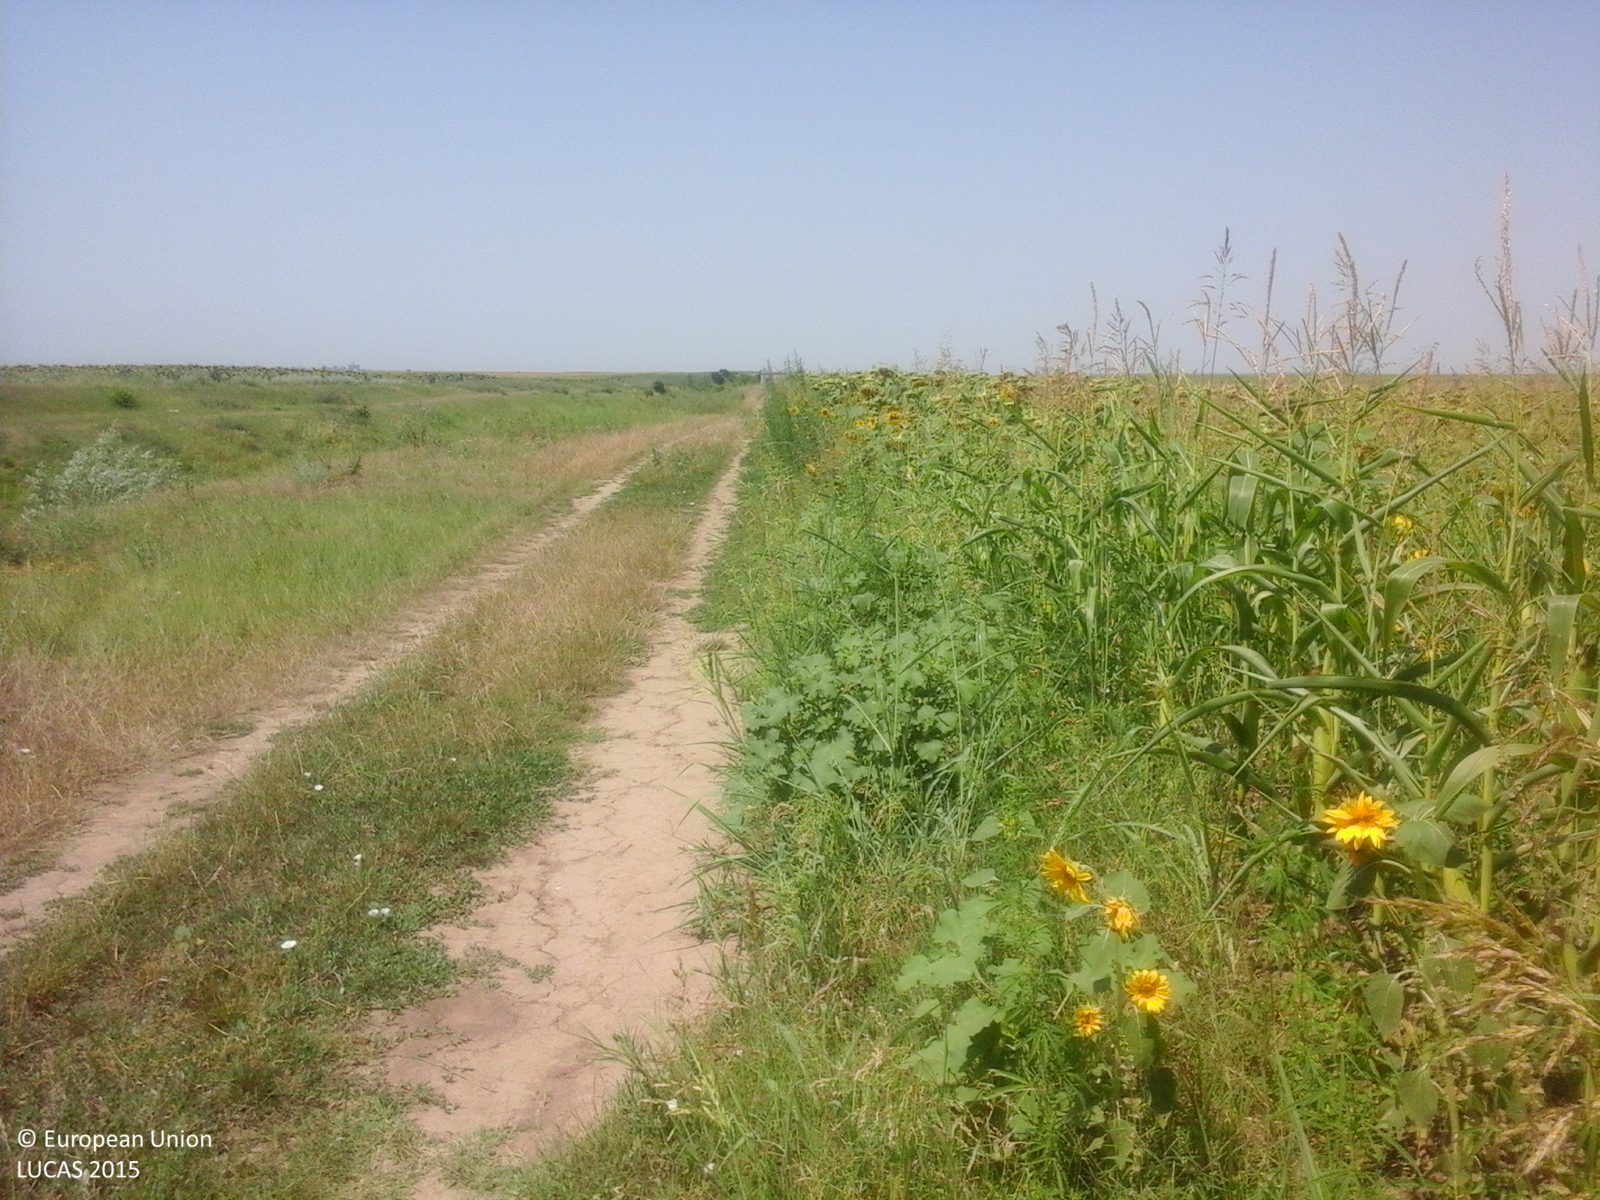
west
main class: Cropland
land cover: Maize
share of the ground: > 75 %
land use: Agriculture (excluding fallow land and kitchen gardens)
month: July
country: RO
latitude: 44.4665
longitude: 26.7517
